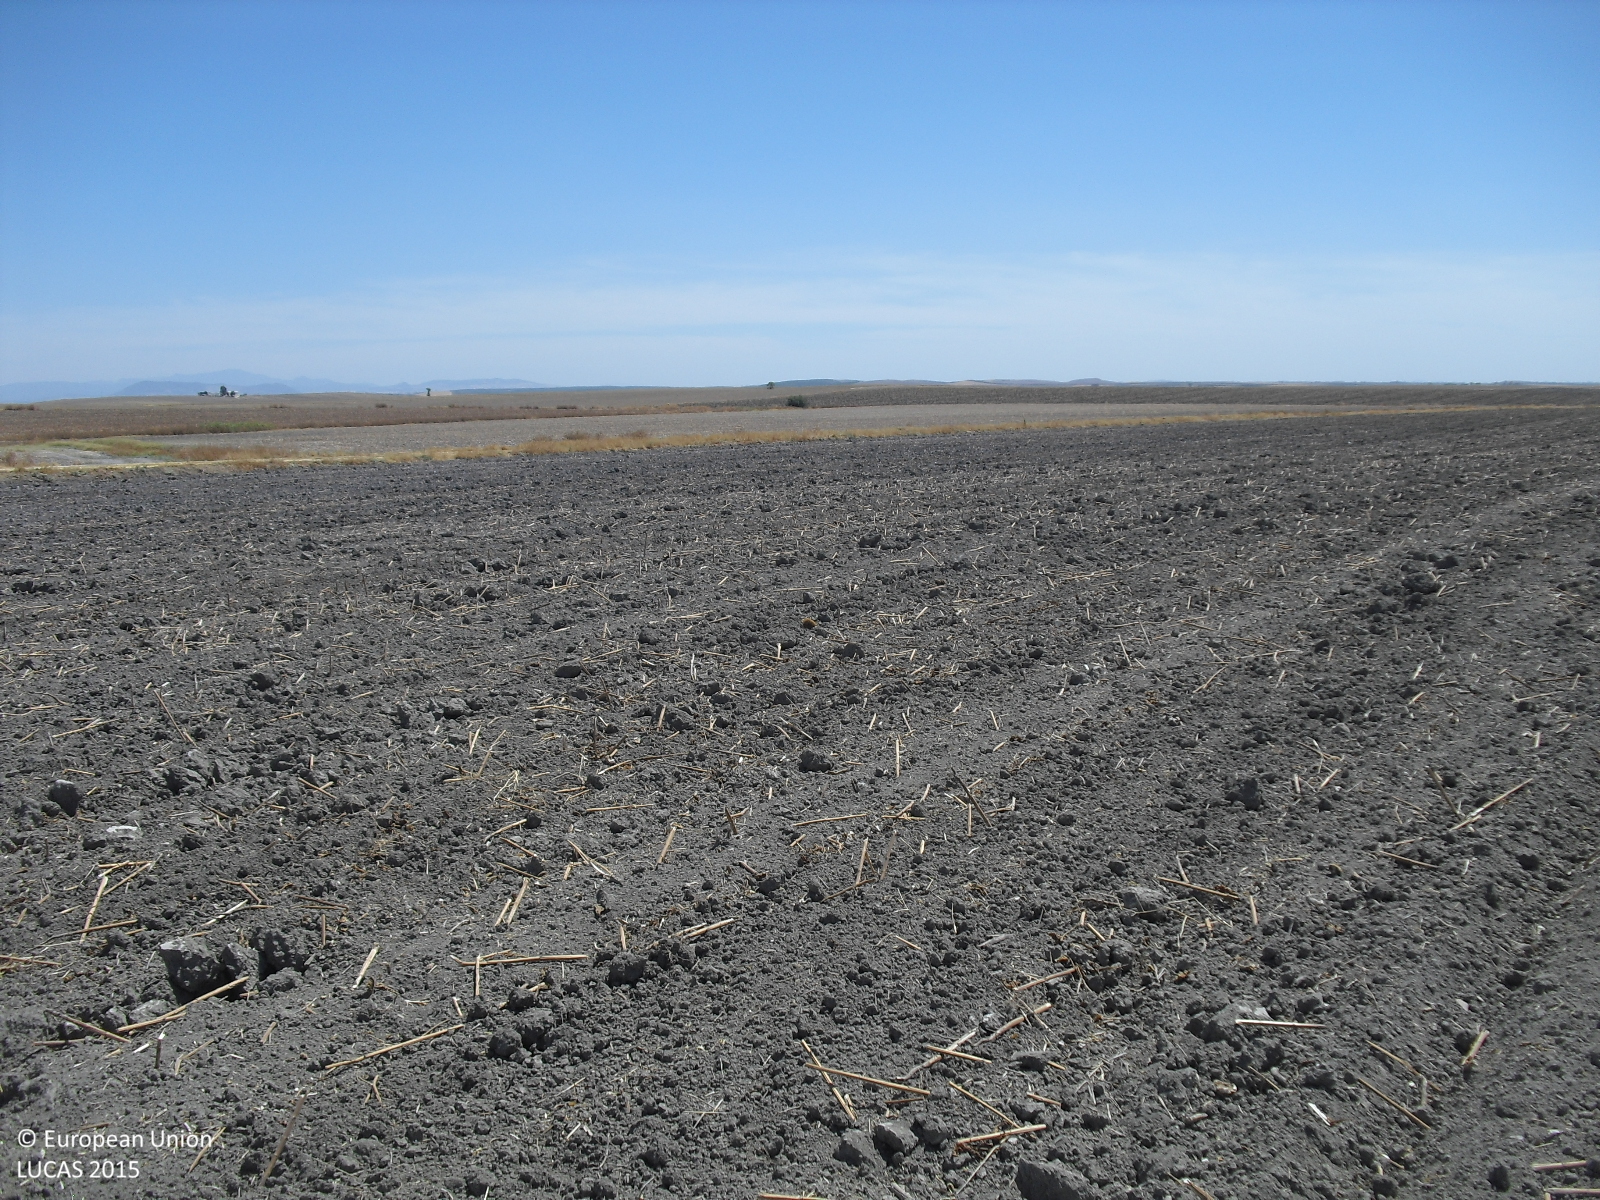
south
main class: Cropland
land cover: Sunflower
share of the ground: < 10 %
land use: Agriculture (excluding fallow land and kitchen gardens)
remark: Harvested field
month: August
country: ES
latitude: 37.3959
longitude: -5.5716
